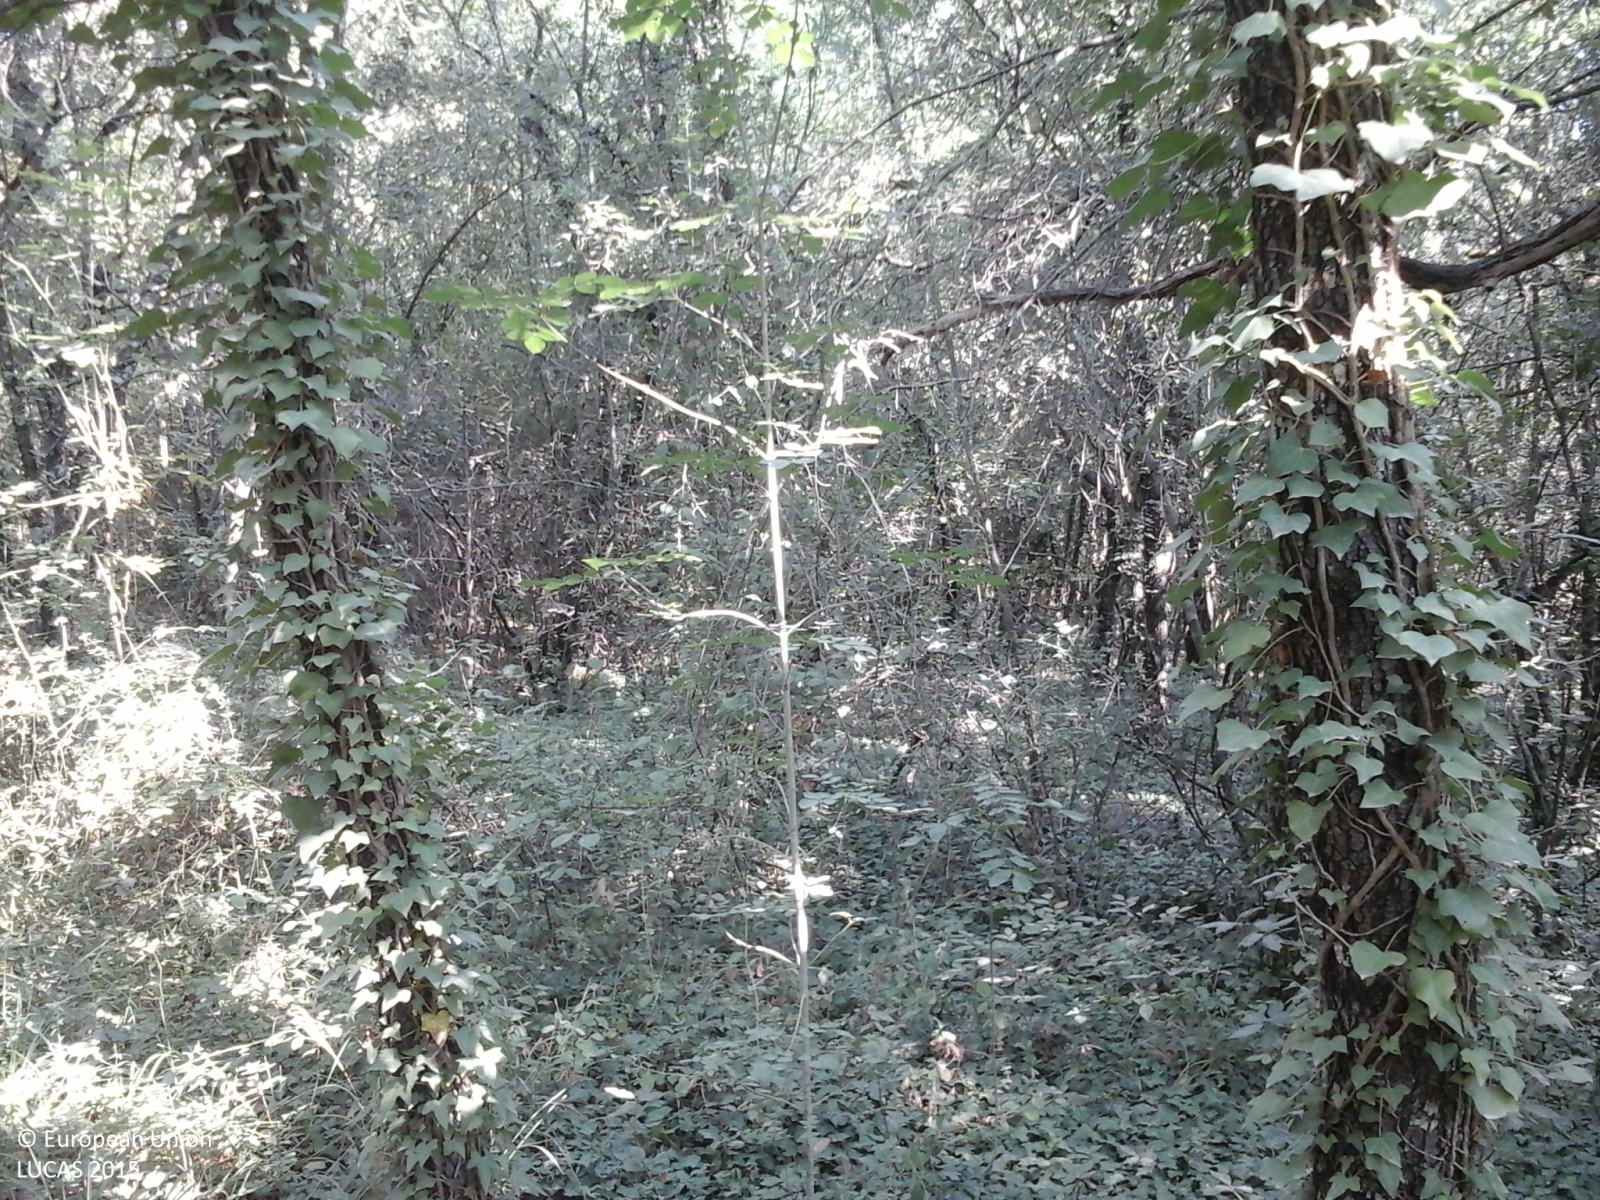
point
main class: Woodland
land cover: Broadleaved woodland
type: mesophytic deciduous forest
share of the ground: > 75 %
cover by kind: broadleaved forest trees 100 %
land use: Forestry
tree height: > 5 m
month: July
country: IT
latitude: 43.2984
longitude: 11.0693
